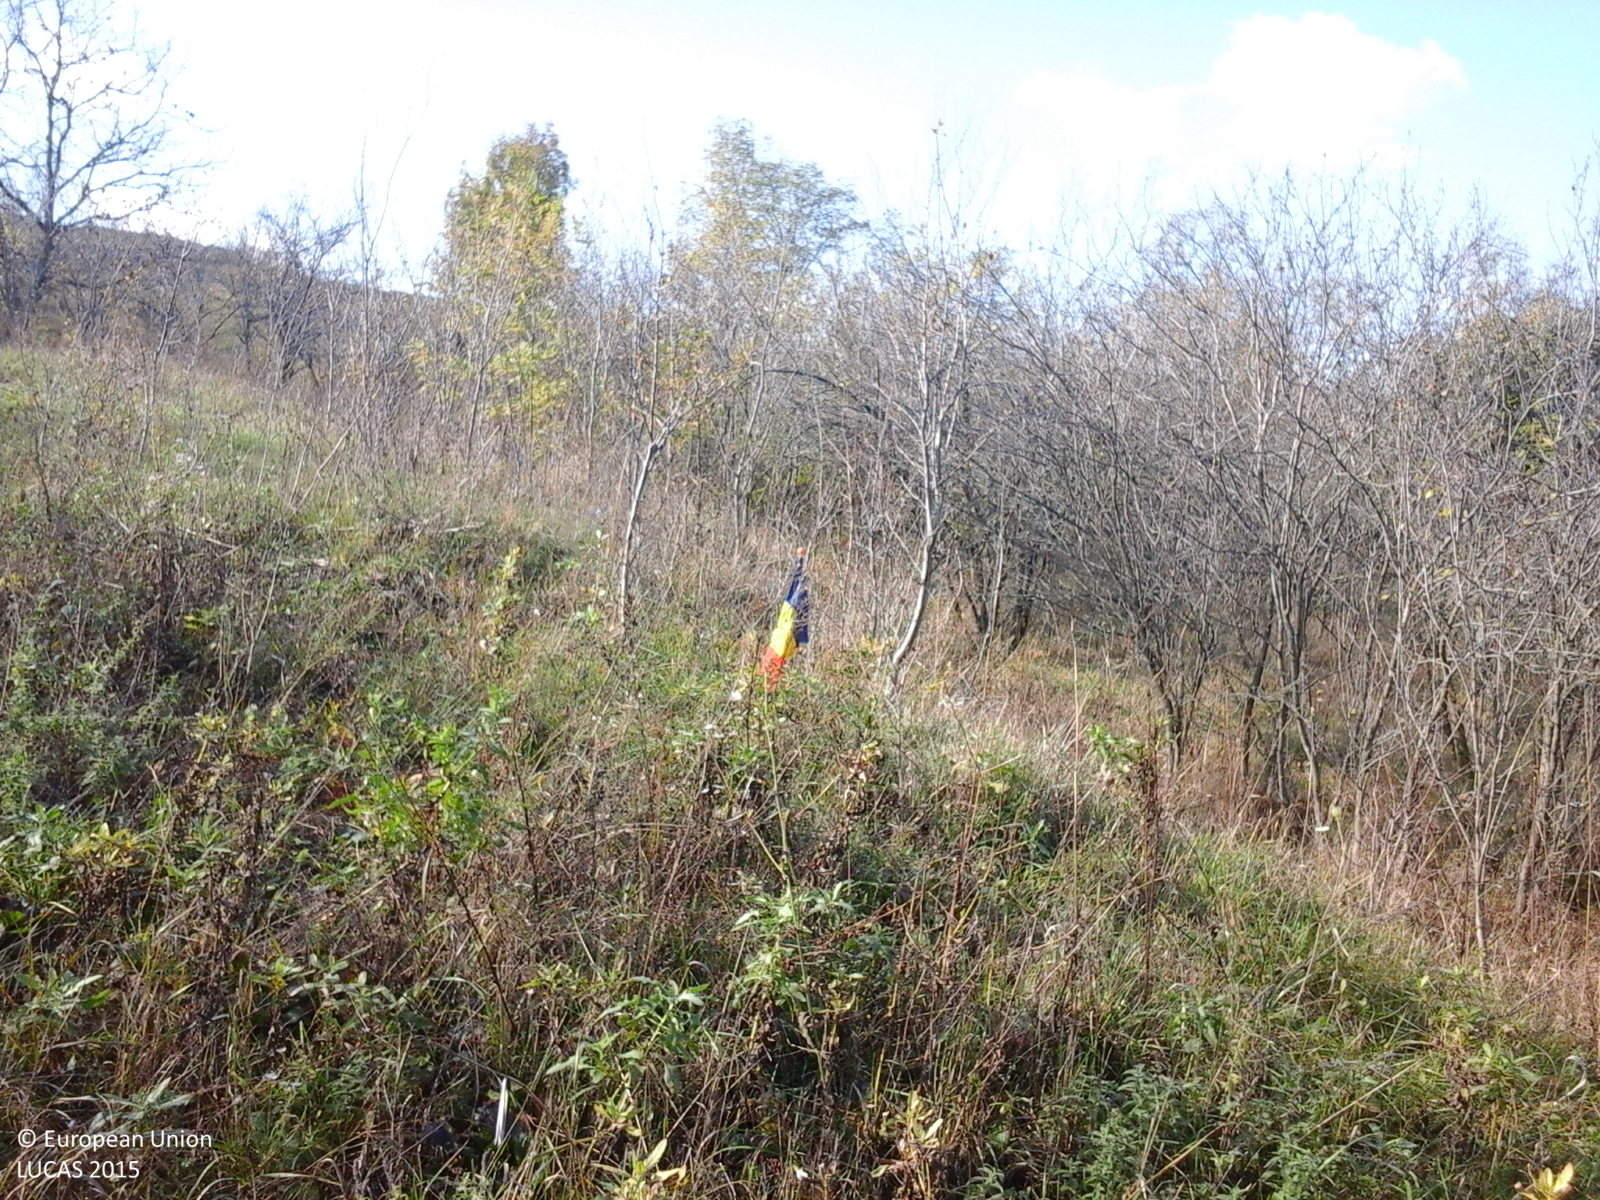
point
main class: Grassland
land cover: Grassland with sparse tree/shrub cover
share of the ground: > 75 %
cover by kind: herbaceous plants 85 %, shrubs 10 %, broadleaved forest trees 5 %
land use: Agriculture (excluding fallow land and kitchen gardens)
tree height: > 5 m
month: October
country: RO
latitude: 45.6070
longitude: 26.9746
